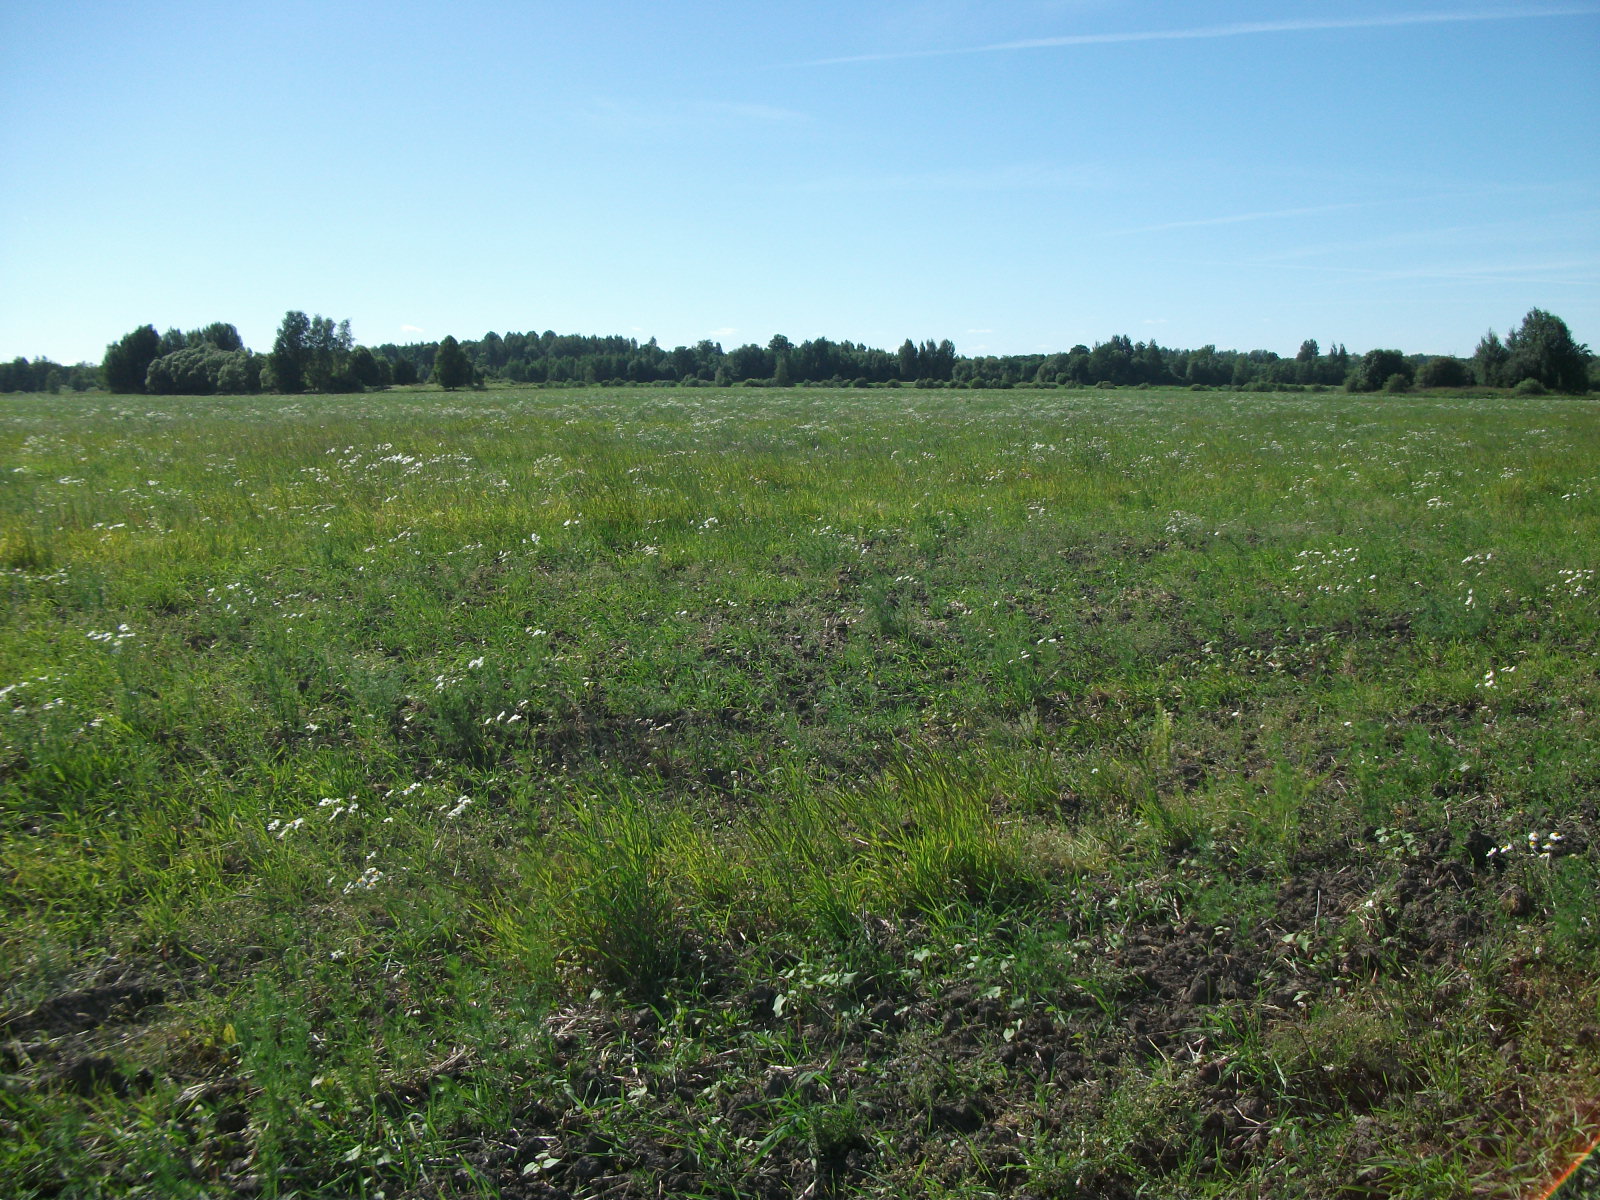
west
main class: Grassland
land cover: Spontaneously vegetated surfaces
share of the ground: > 75 %
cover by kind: herbaceous plants 80 %, unconsolidated bare surface 20 %
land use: Fallow land
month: July
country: LV
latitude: 56.7436
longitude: 26.3790
